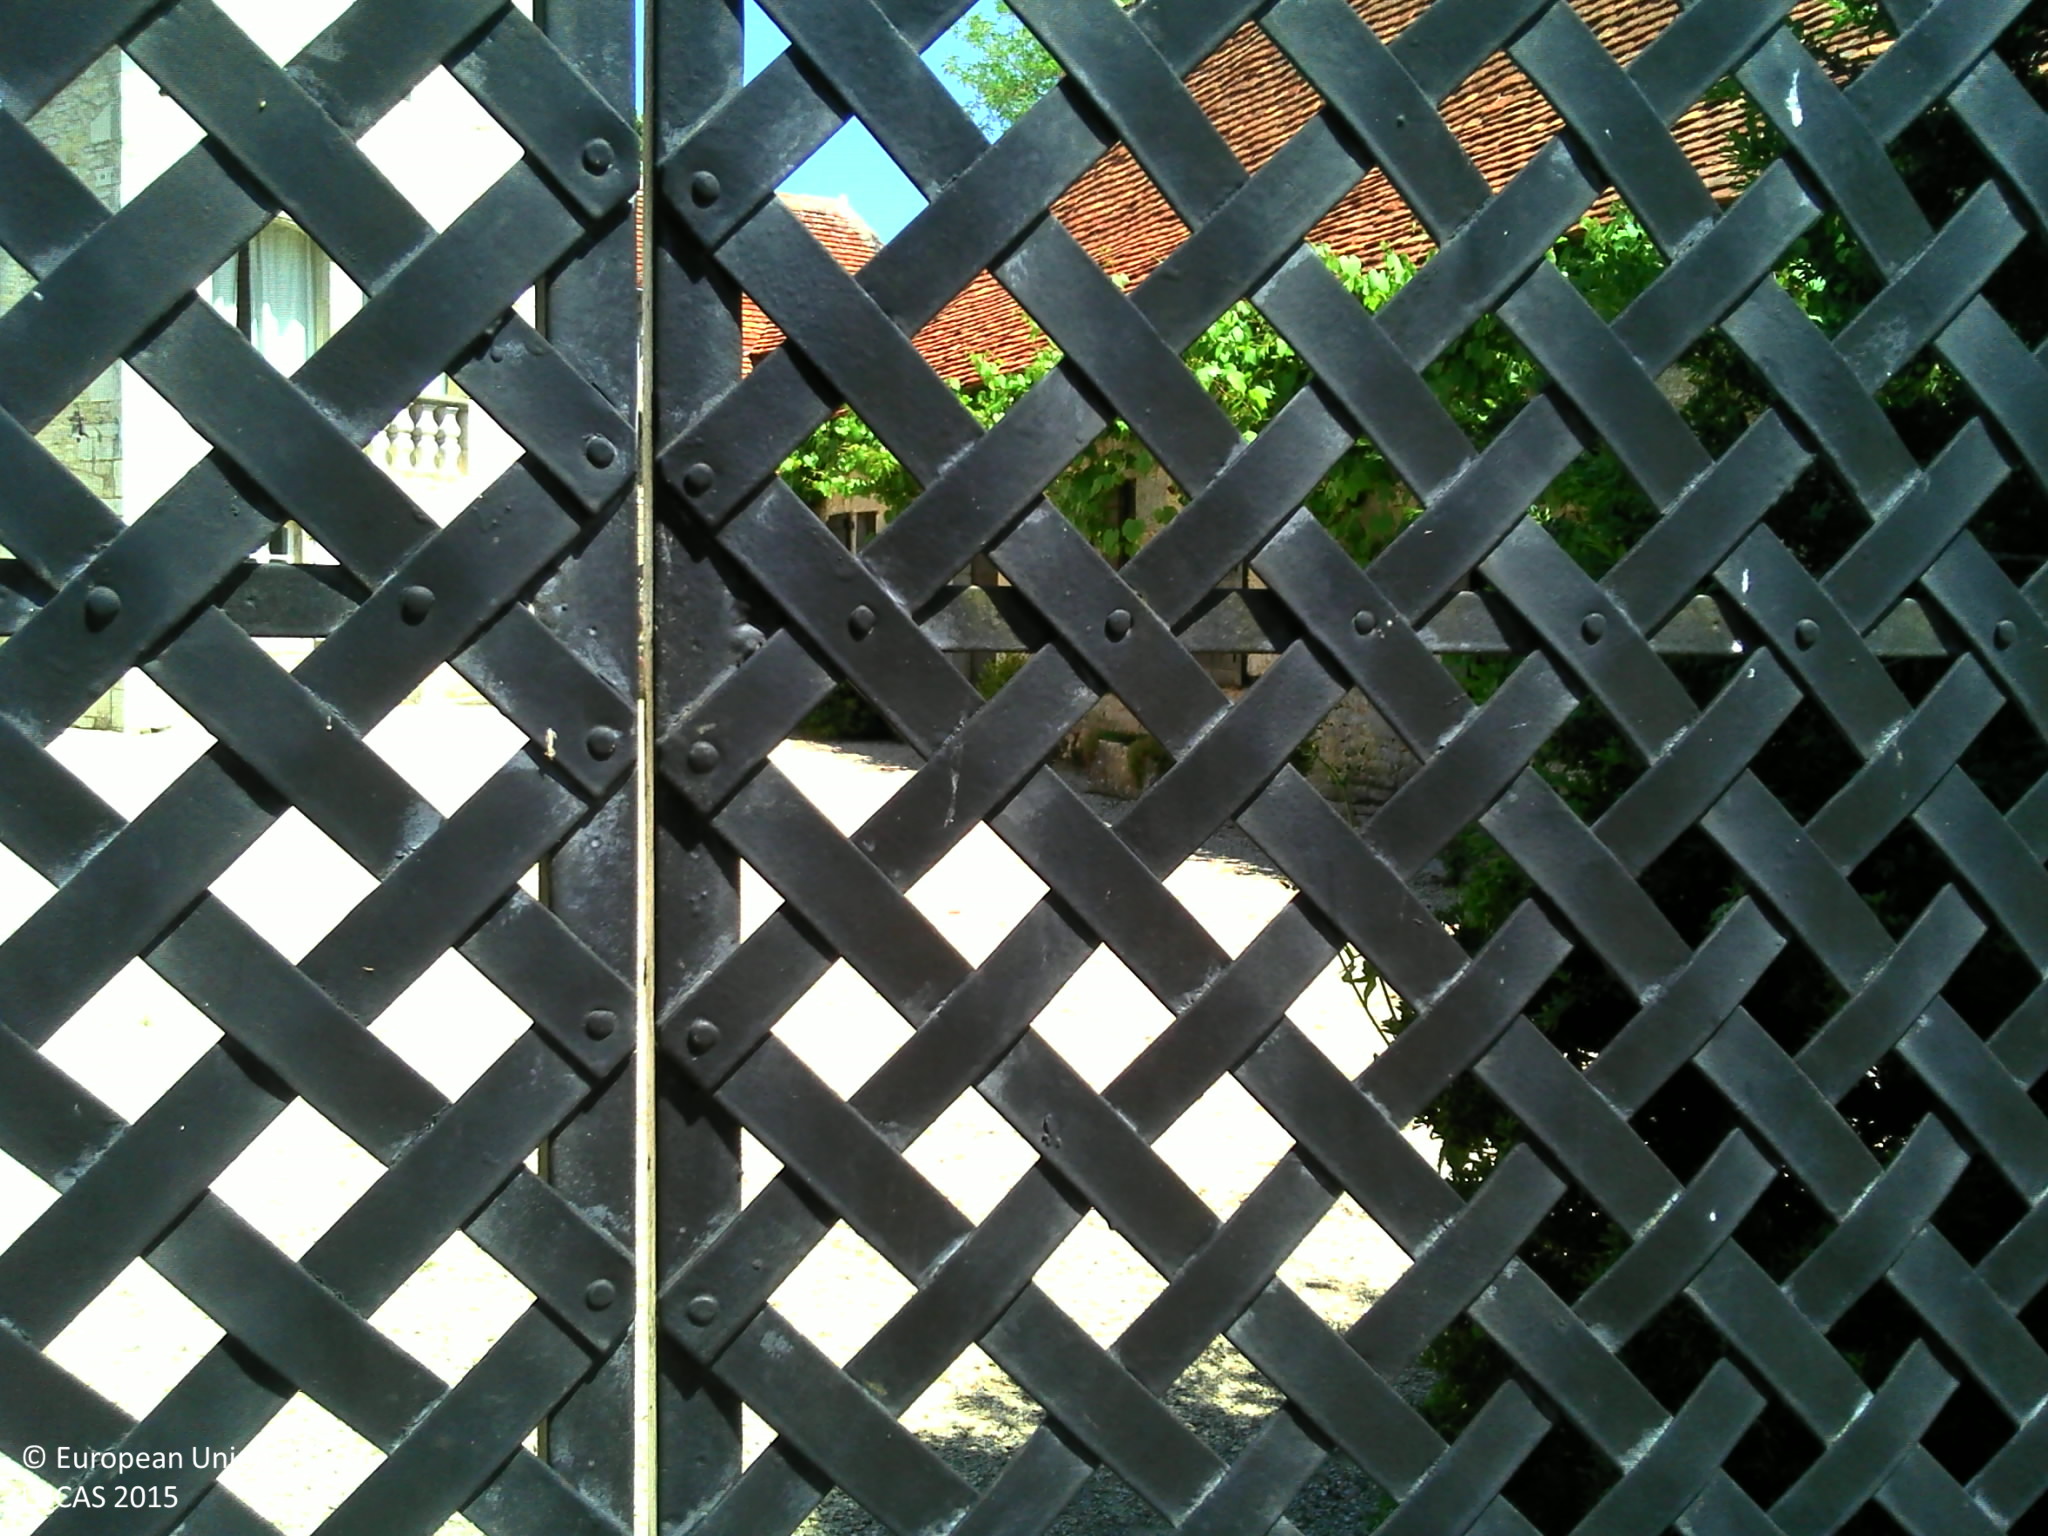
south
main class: Woodland
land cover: Broadleaved woodland
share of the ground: > 75 %
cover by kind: broadleaved forest trees 50 %, herbaceous plants 50 %
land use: Residential
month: May
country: FR
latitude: 44.6290
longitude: 1.8693
